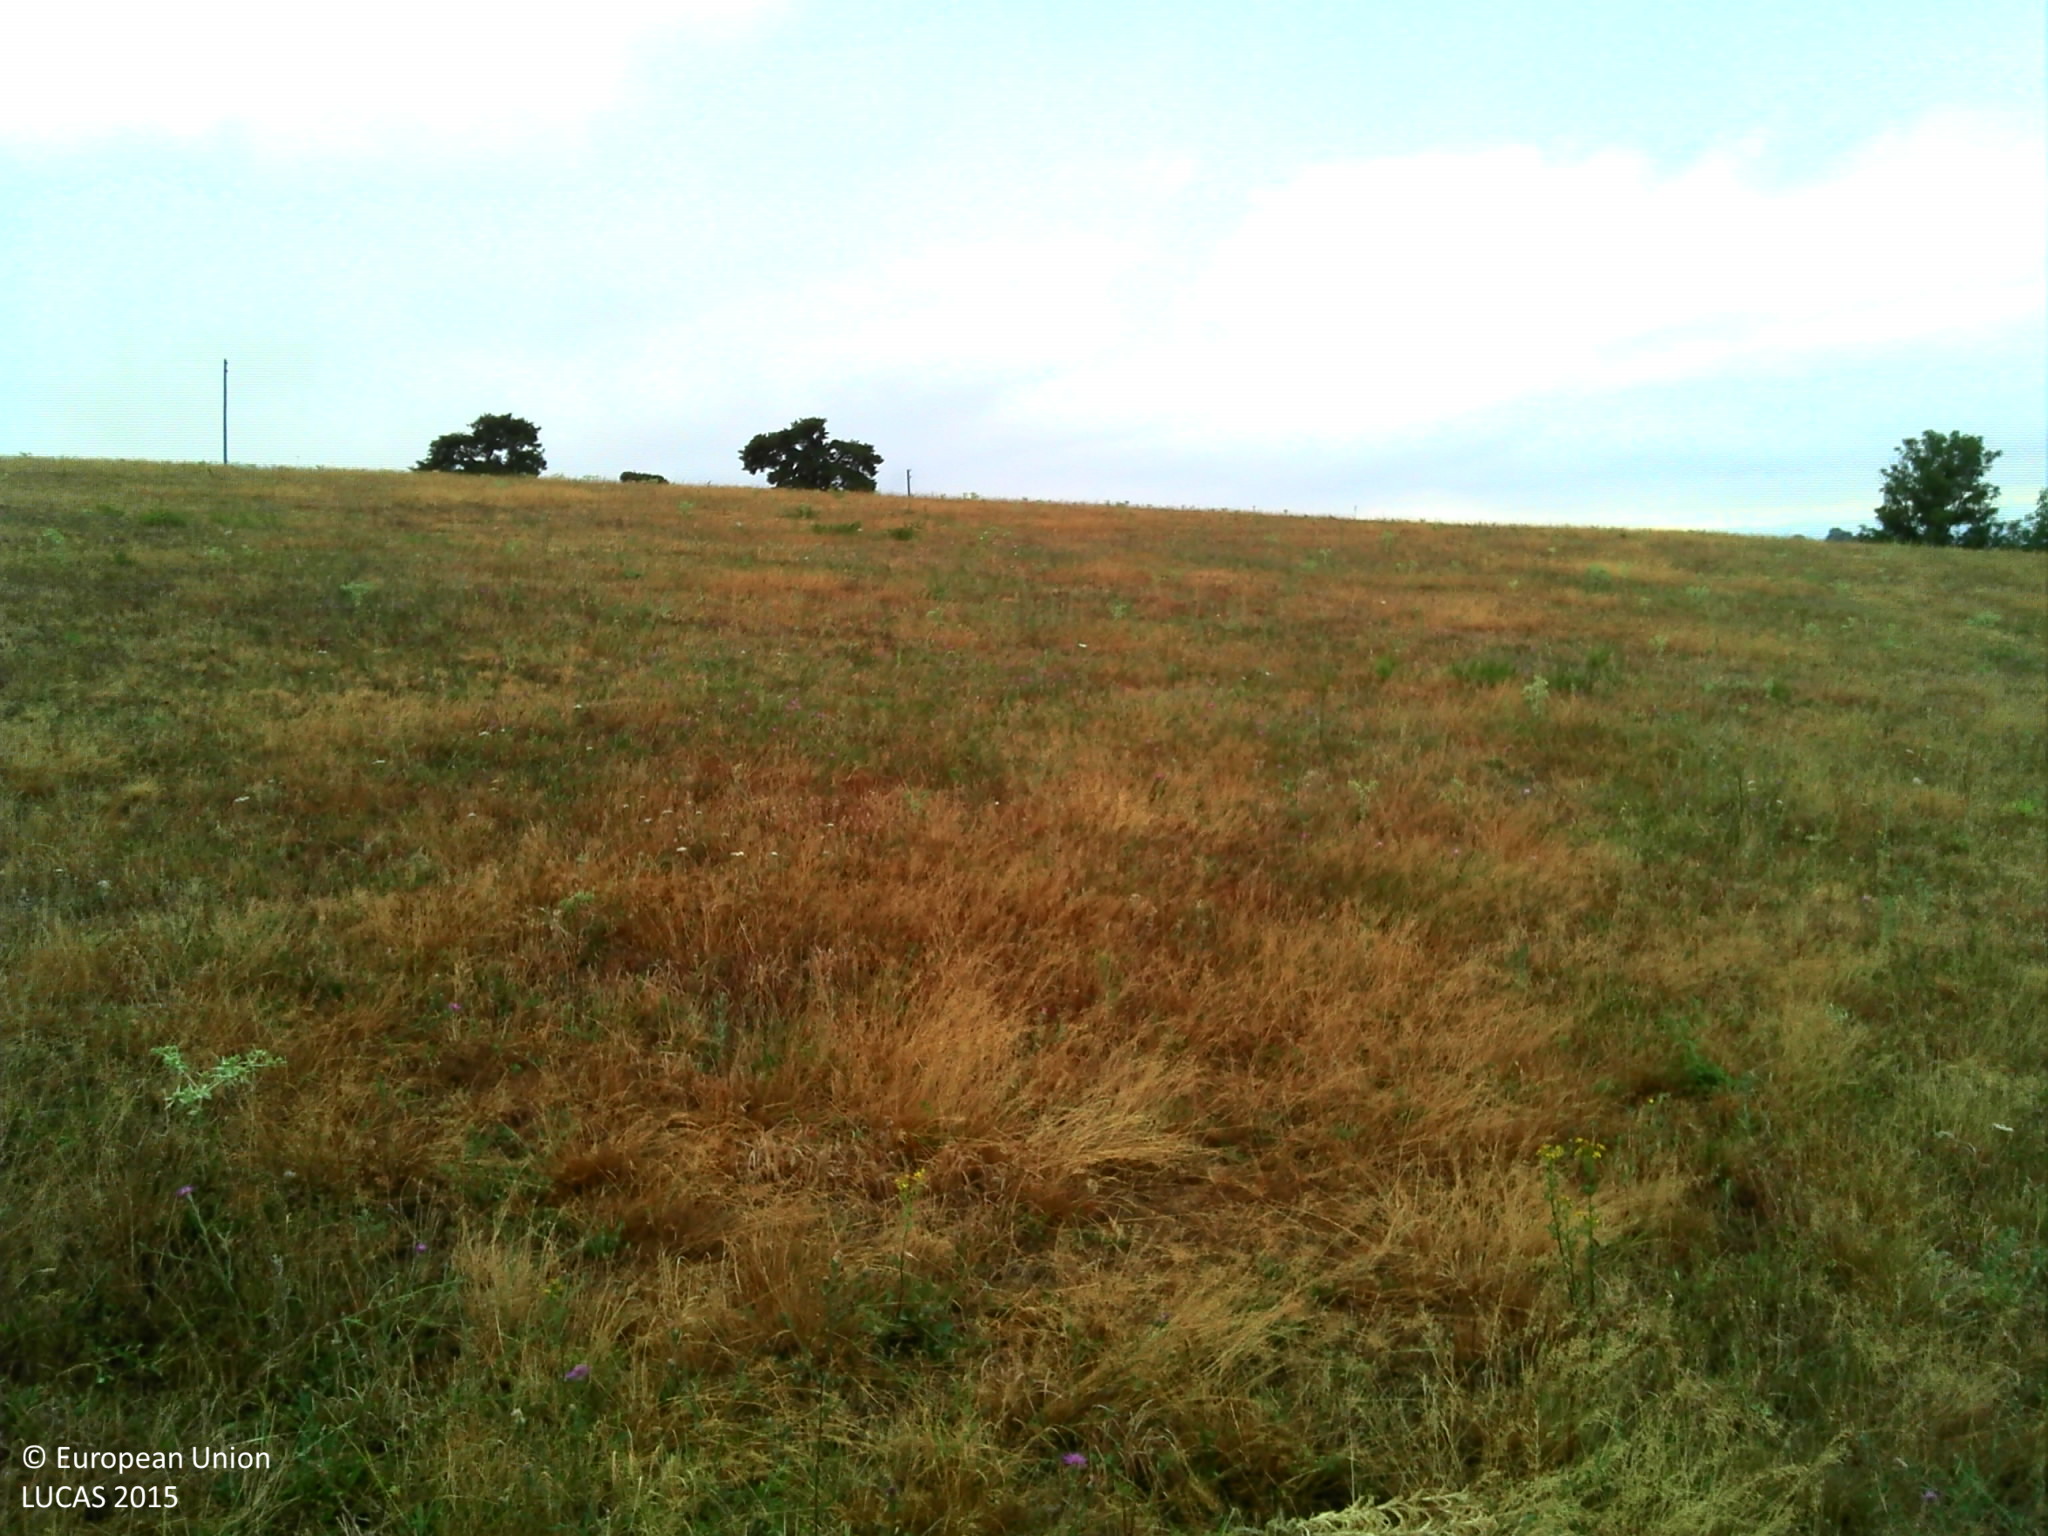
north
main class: Grassland
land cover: Grassland without tree/shrub cover
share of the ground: > 75 %
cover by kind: herbaceous plants 90 %, unconsolidated bare surface 10 %
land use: Agriculture (excluding fallow land and kitchen gardens)
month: August
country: FR
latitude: 45.4856
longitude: 4.1306
